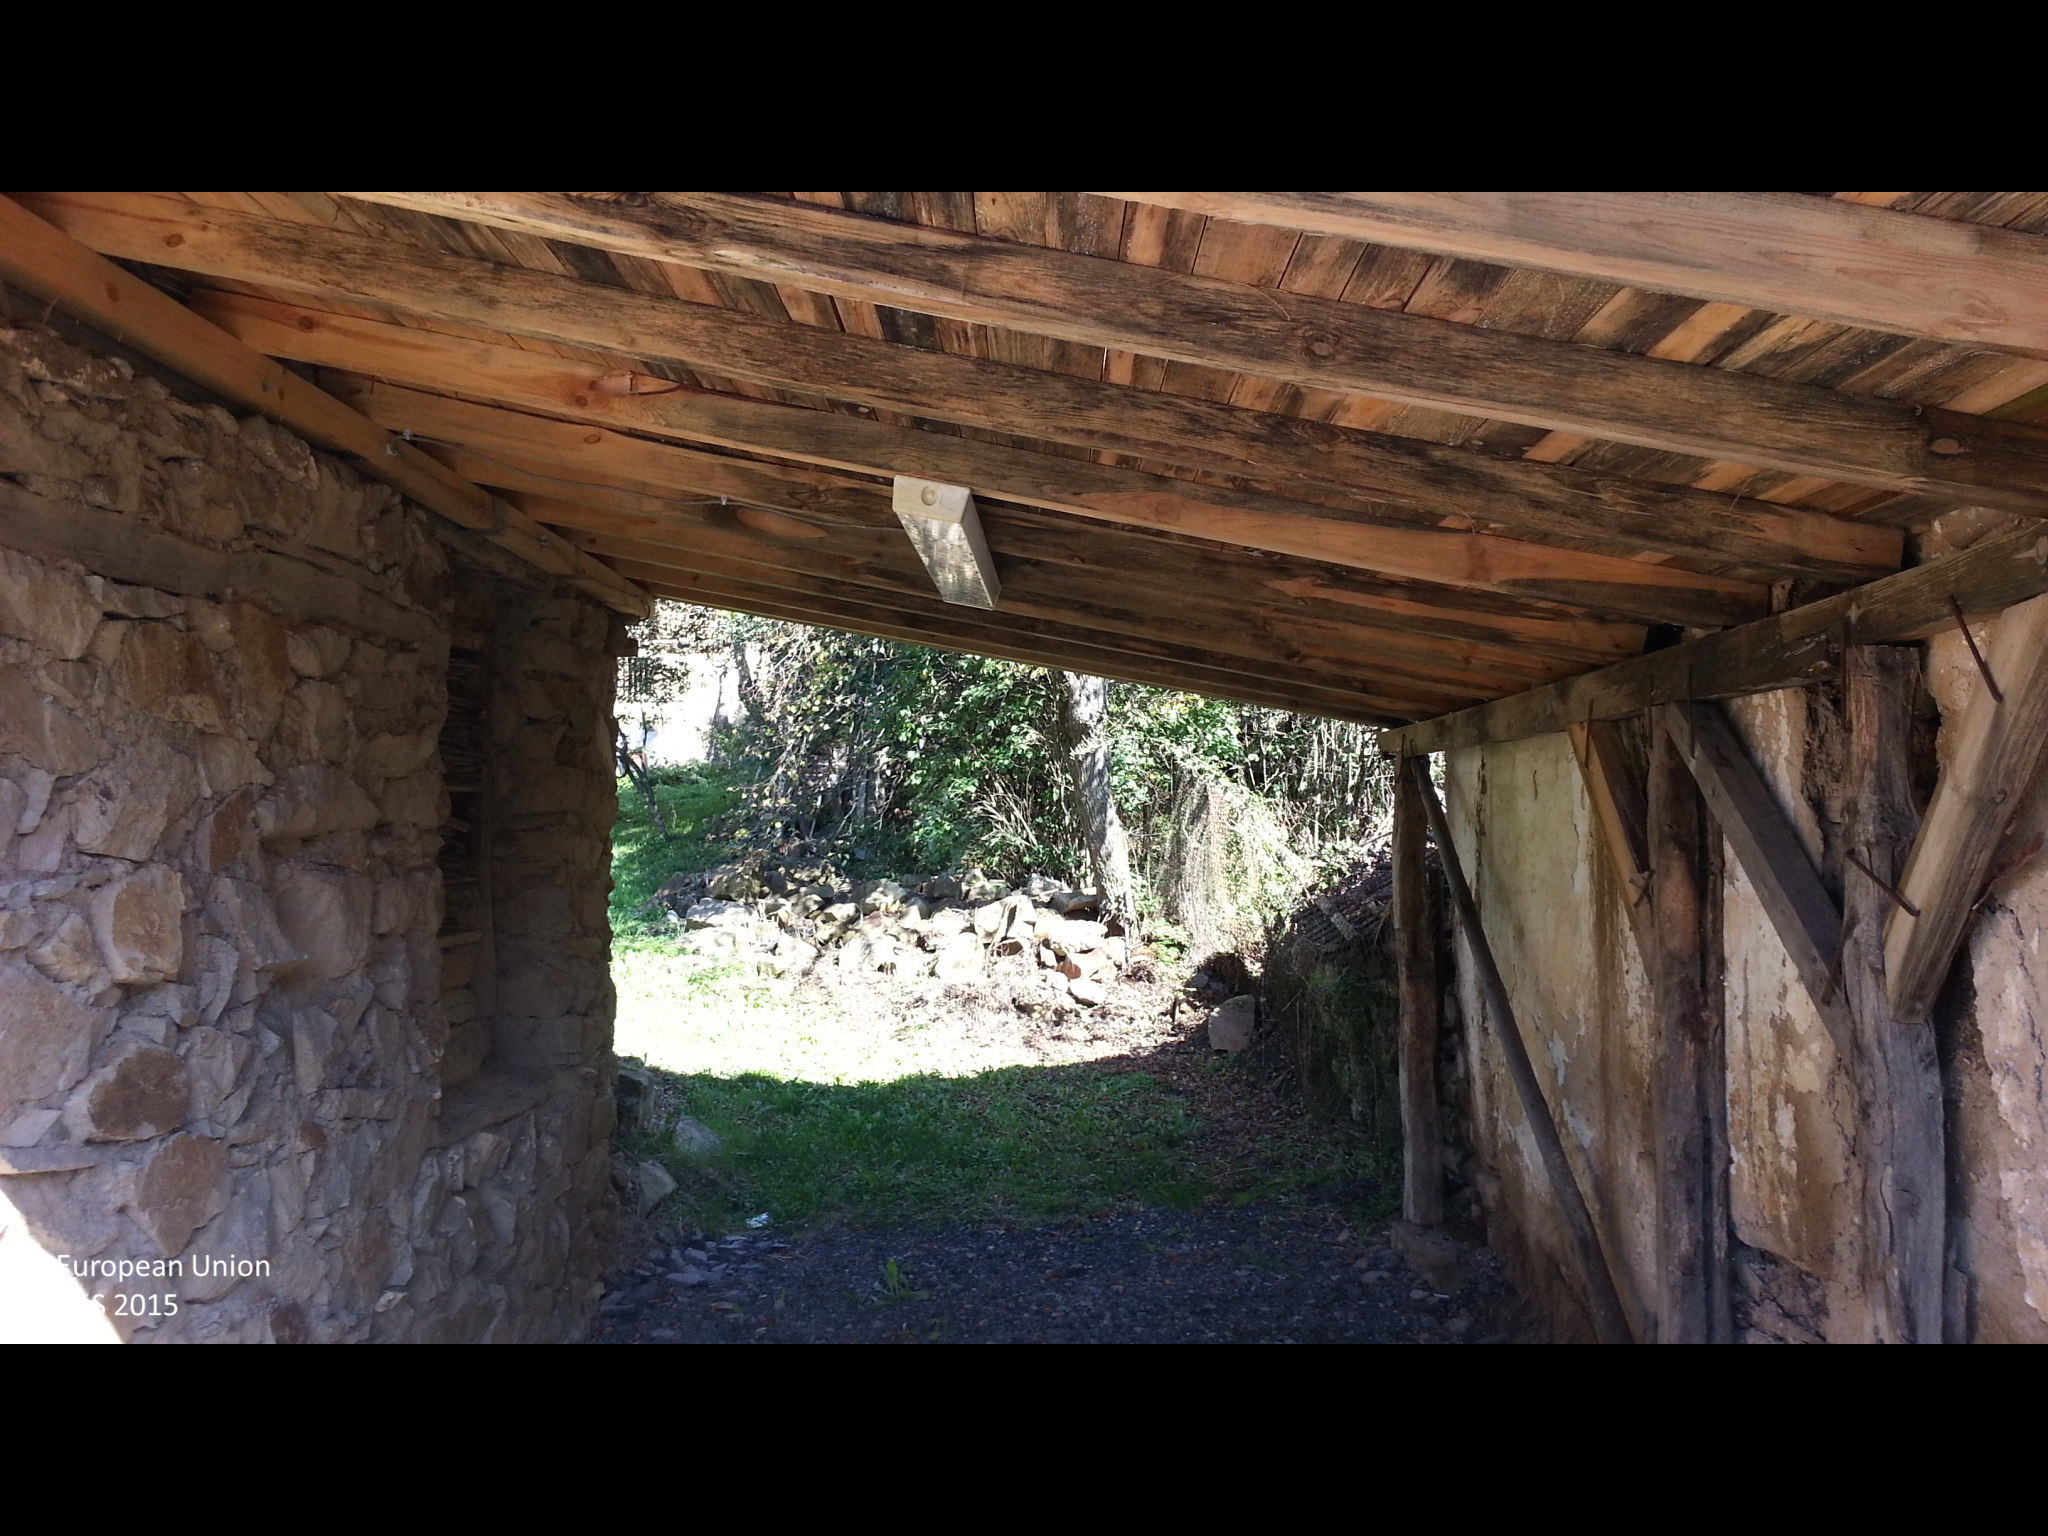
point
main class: Grassland
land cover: Grassland with sparse tree/shrub cover
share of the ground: > 75 %
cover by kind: herbaceous plants 90 %, broadleaved forest trees 5 %, shrubs 5 %
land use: Residential
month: October
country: BG
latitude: 42.6487
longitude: 22.5997
